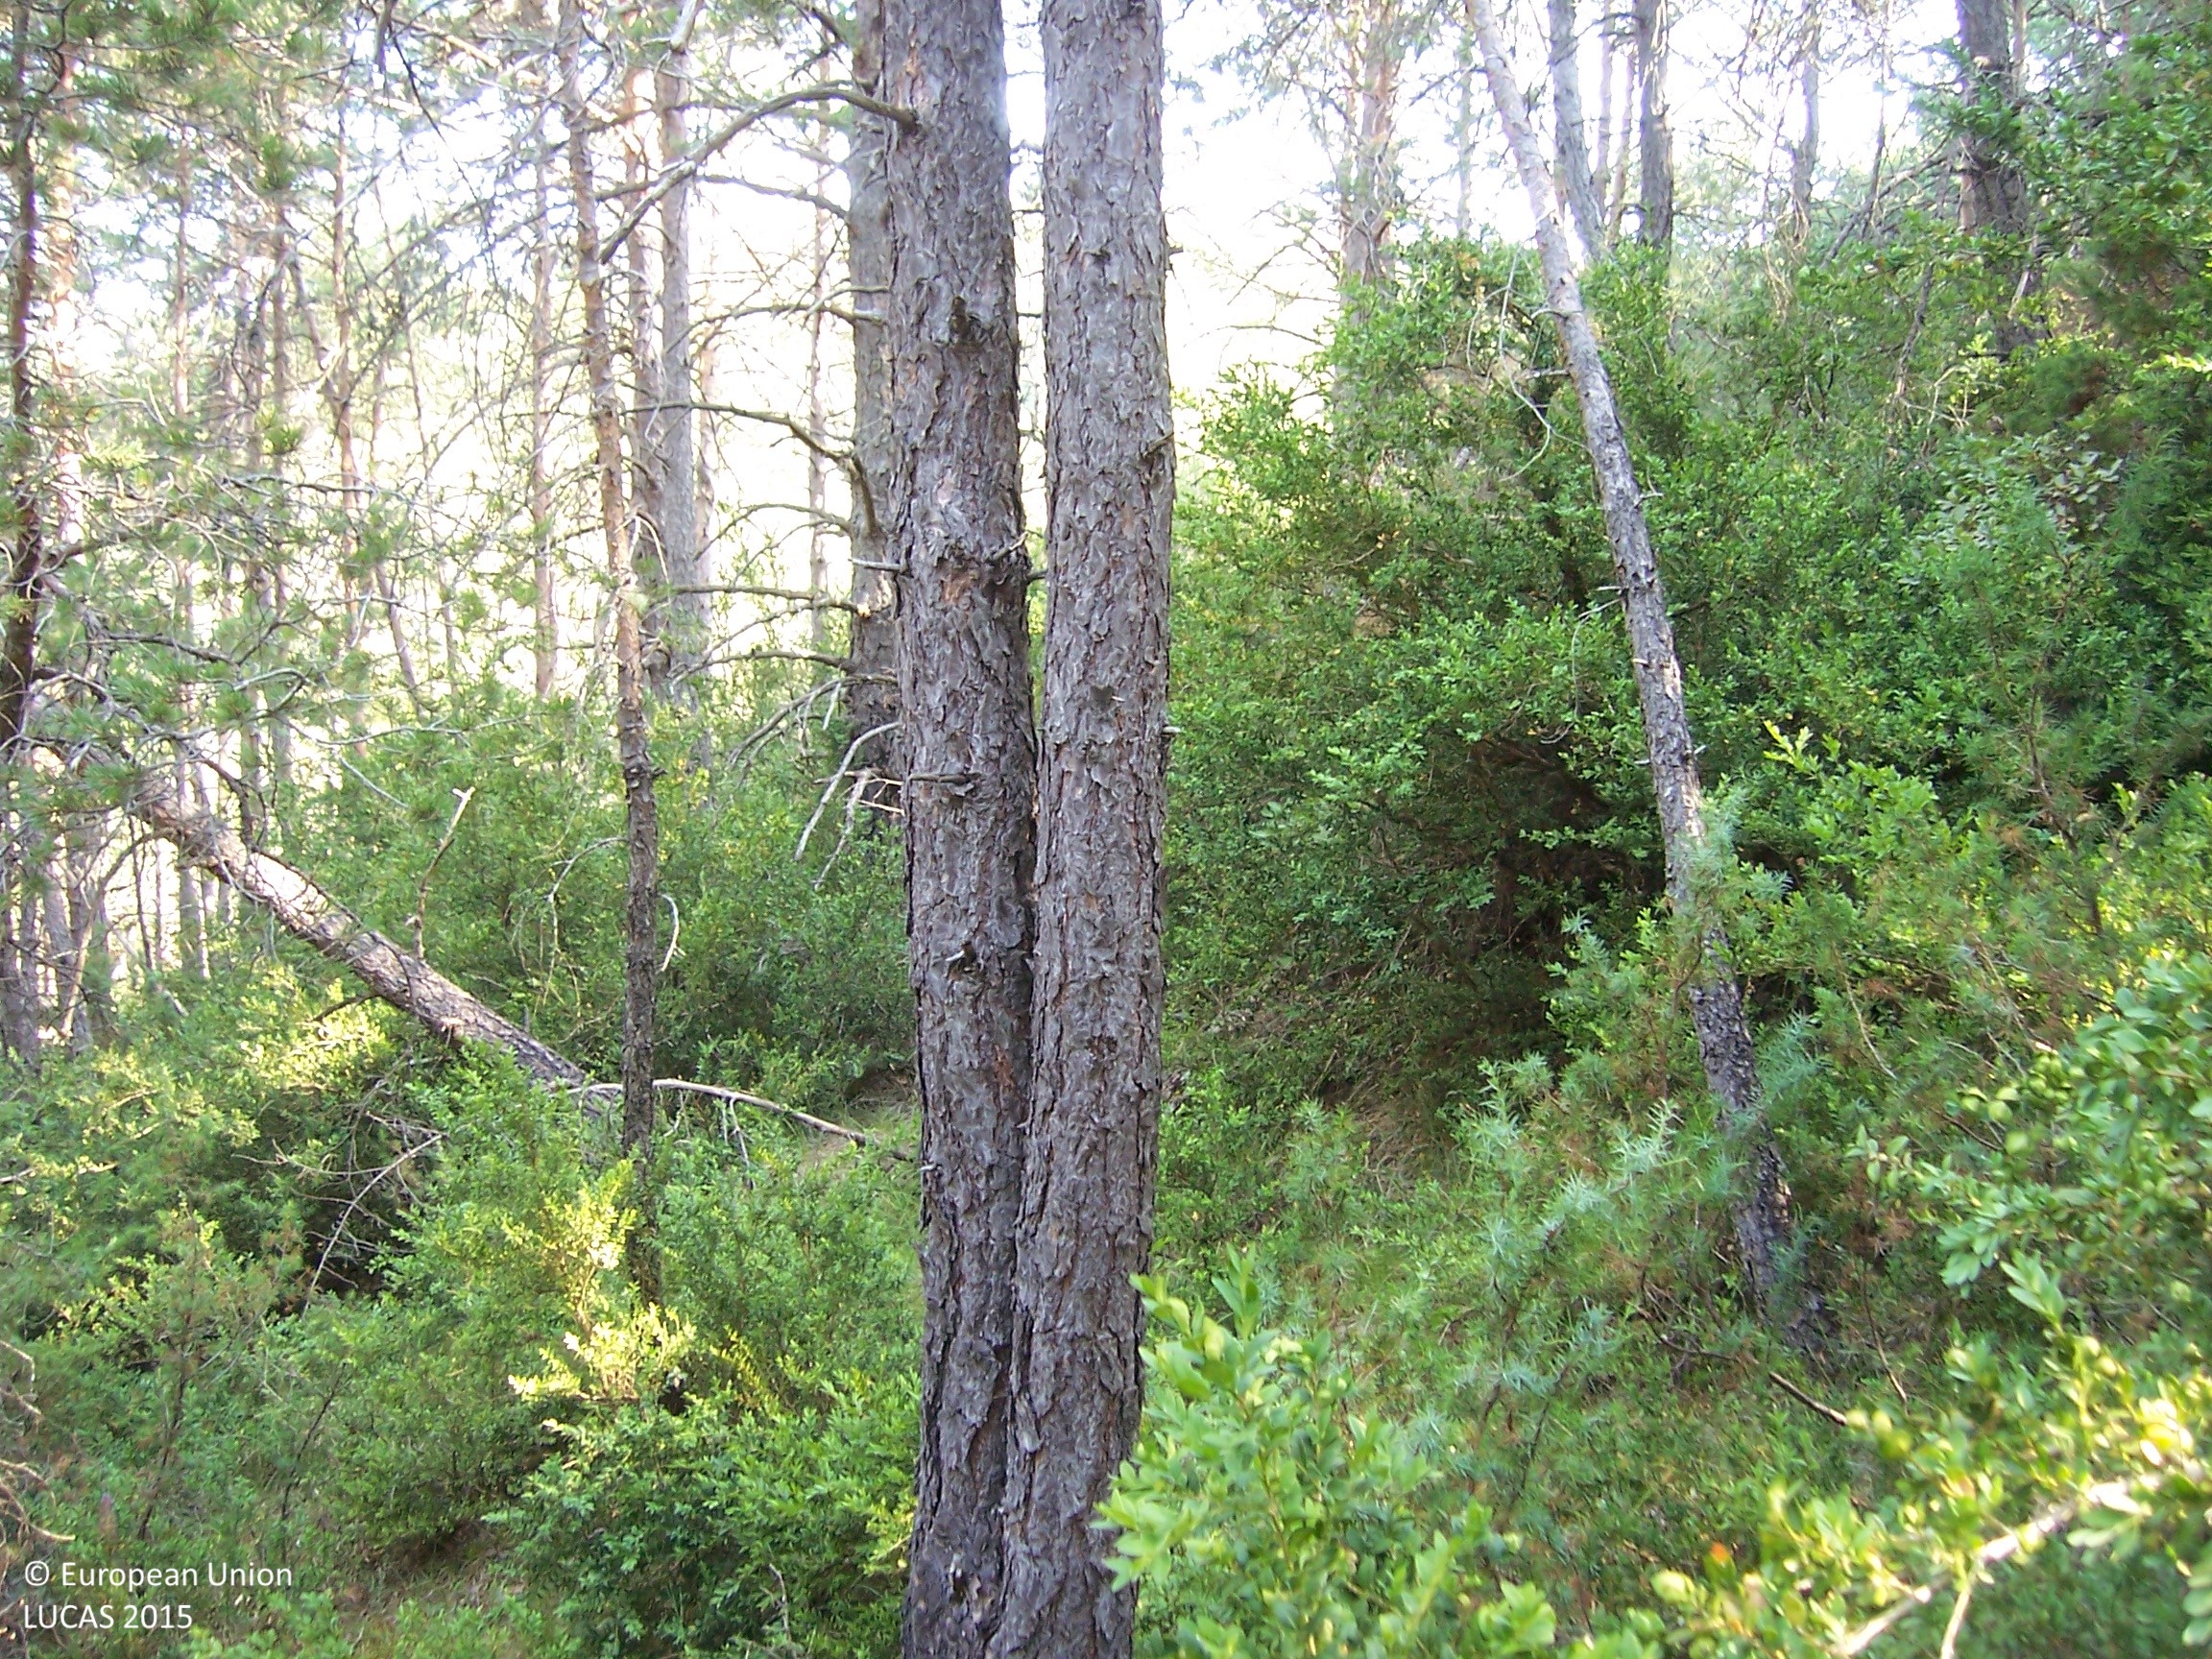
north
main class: Woodland
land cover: Pine dominated coniferous woodland
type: coniferous forest of the mediterranean region
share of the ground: > 75 %
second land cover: Grassland without tree/shrub cover
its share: < 10 %
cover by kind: coniferous forest trees 90 %, herbaceous plants 10 %
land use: Forestry
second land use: Agriculture (excluding fallow land and kitchen gardens)
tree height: > 5 m
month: July
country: ES
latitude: 42.7782
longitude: -1.1938
